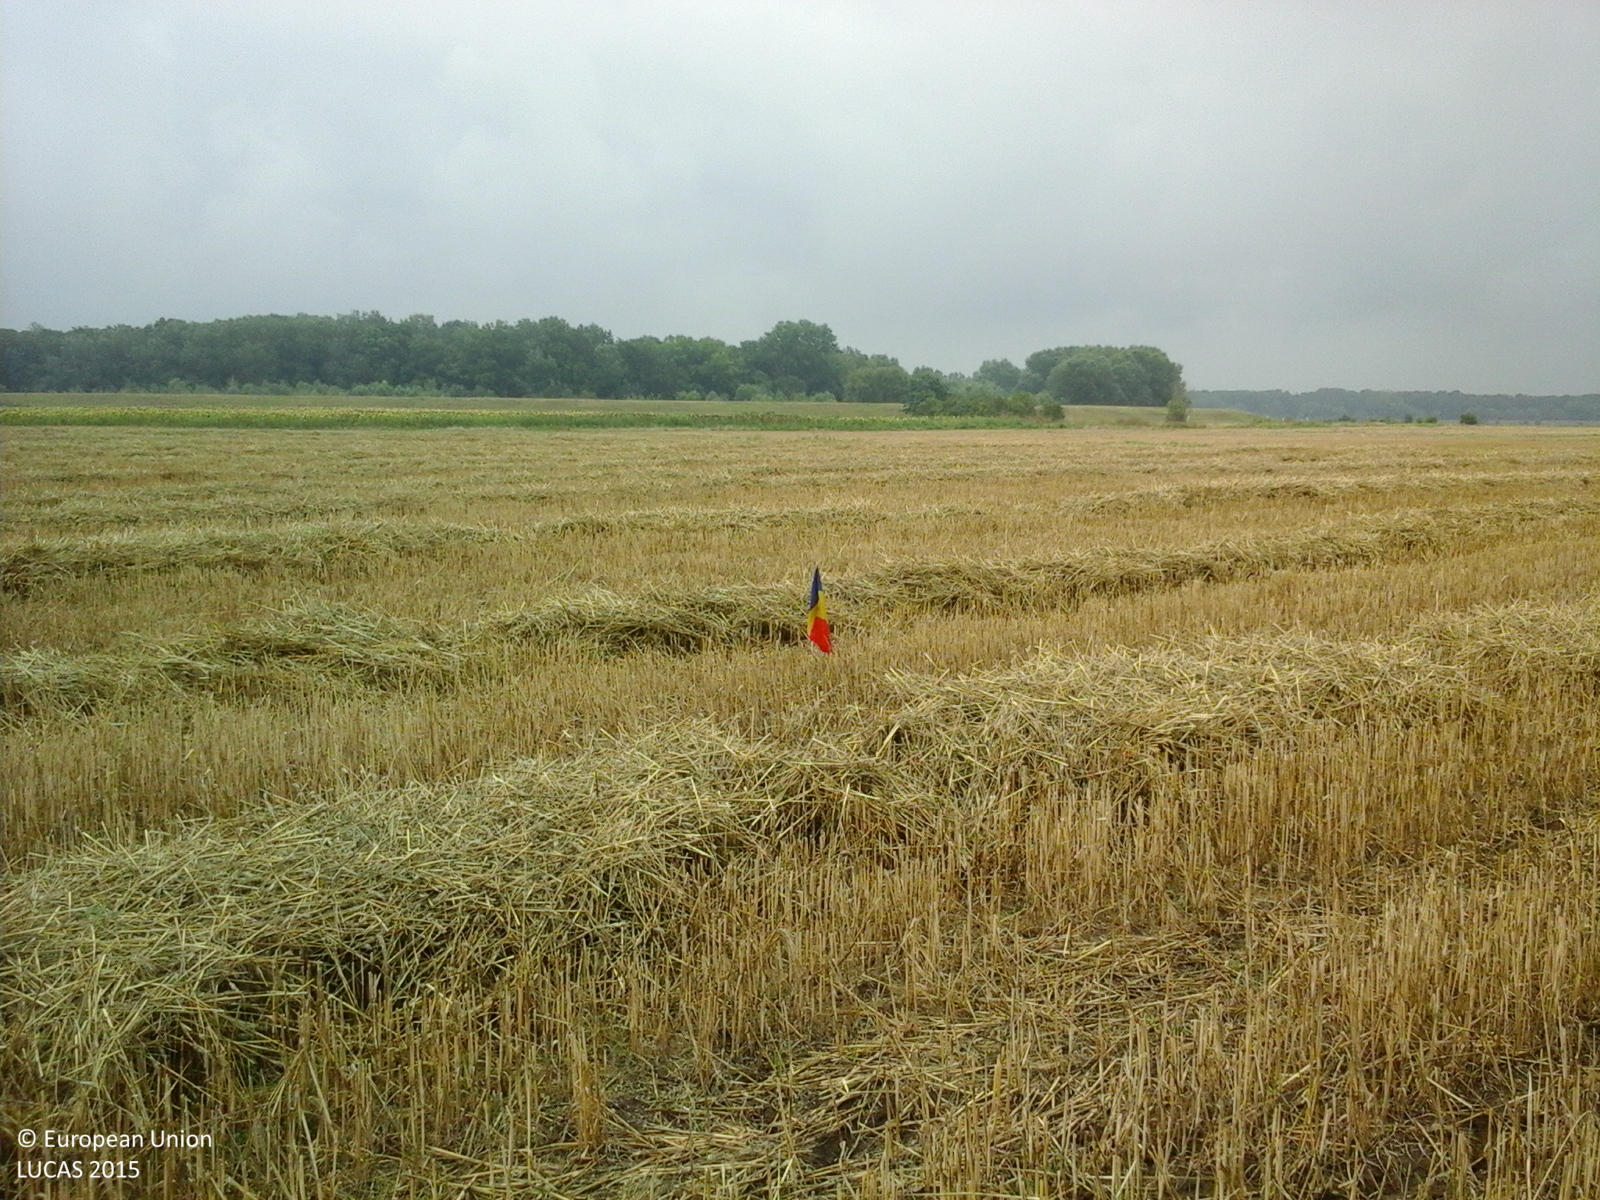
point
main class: Cropland
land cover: Common wheat
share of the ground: < 10 %
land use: Agriculture (excluding fallow land and kitchen gardens)
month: August
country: RO
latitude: 46.1571
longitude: 20.5269
